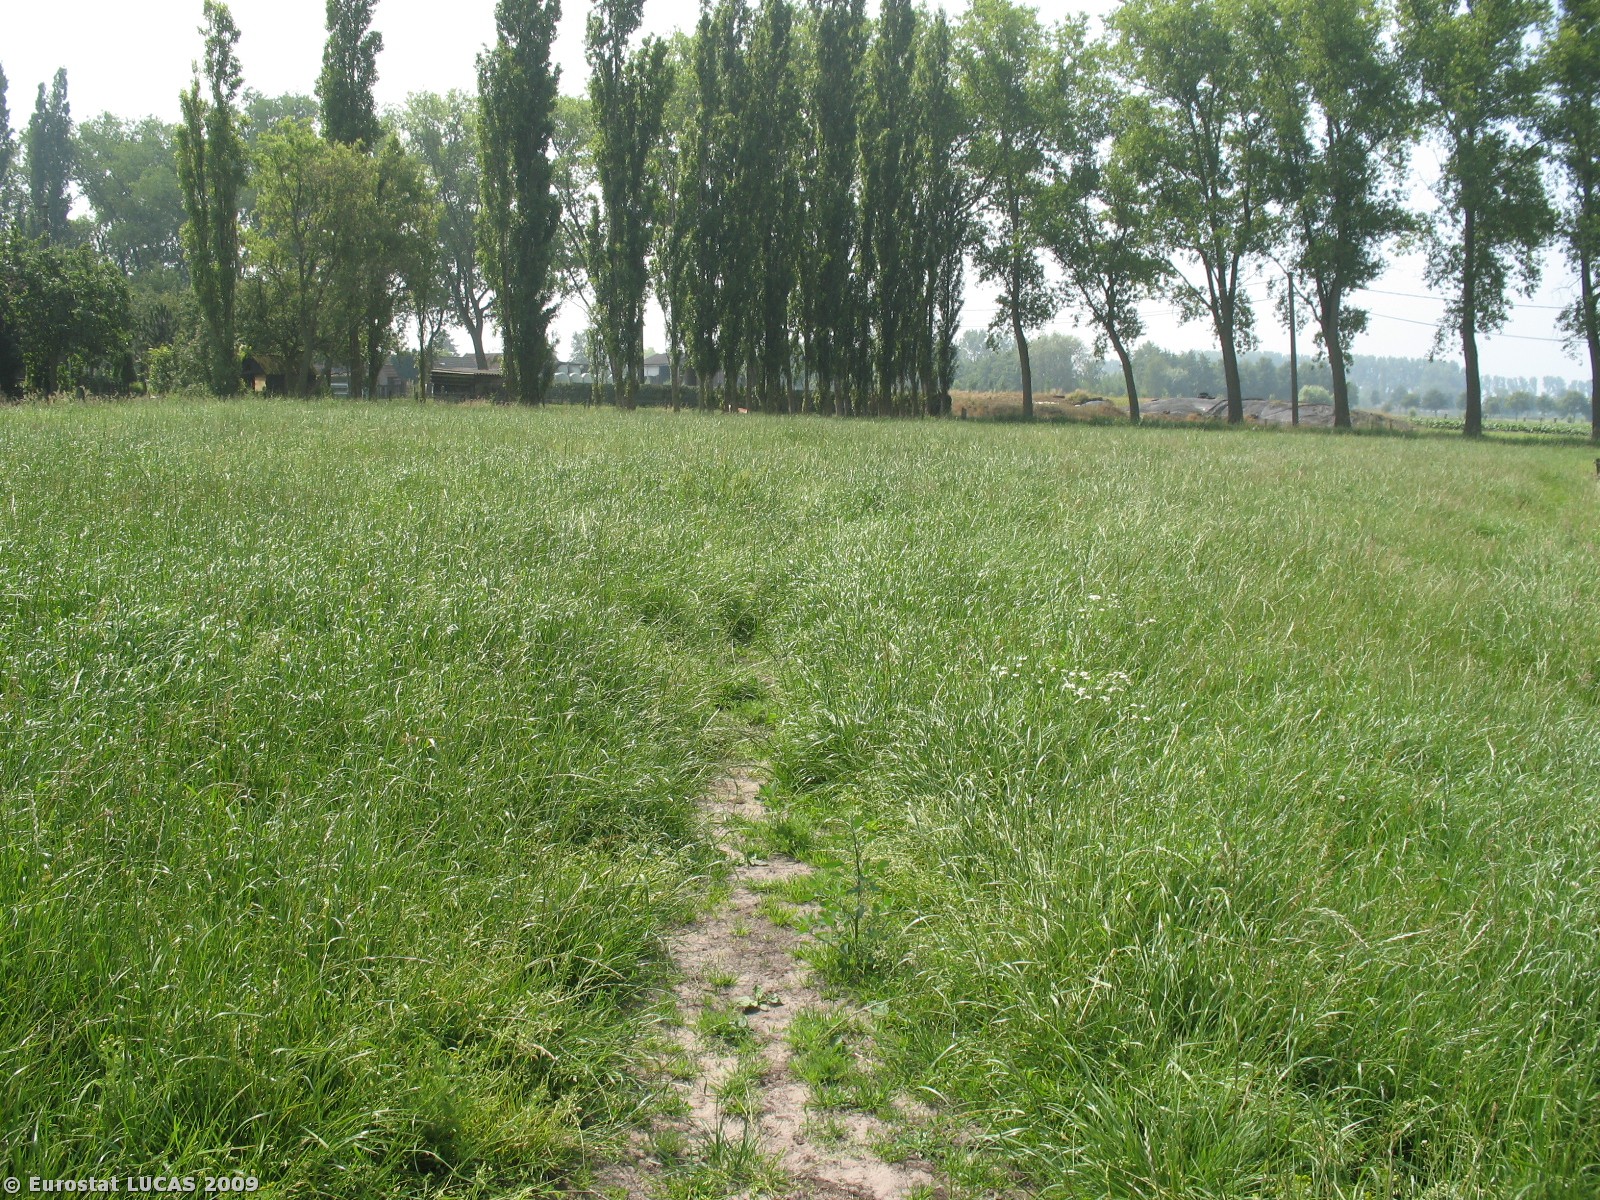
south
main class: Grassland
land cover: Grassland without tree/shrub cover
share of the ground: > 75 %
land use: Agriculture (excluding fallow land and kitchen gardens)
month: June
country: BE
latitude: 51.2188
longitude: 3.7077
